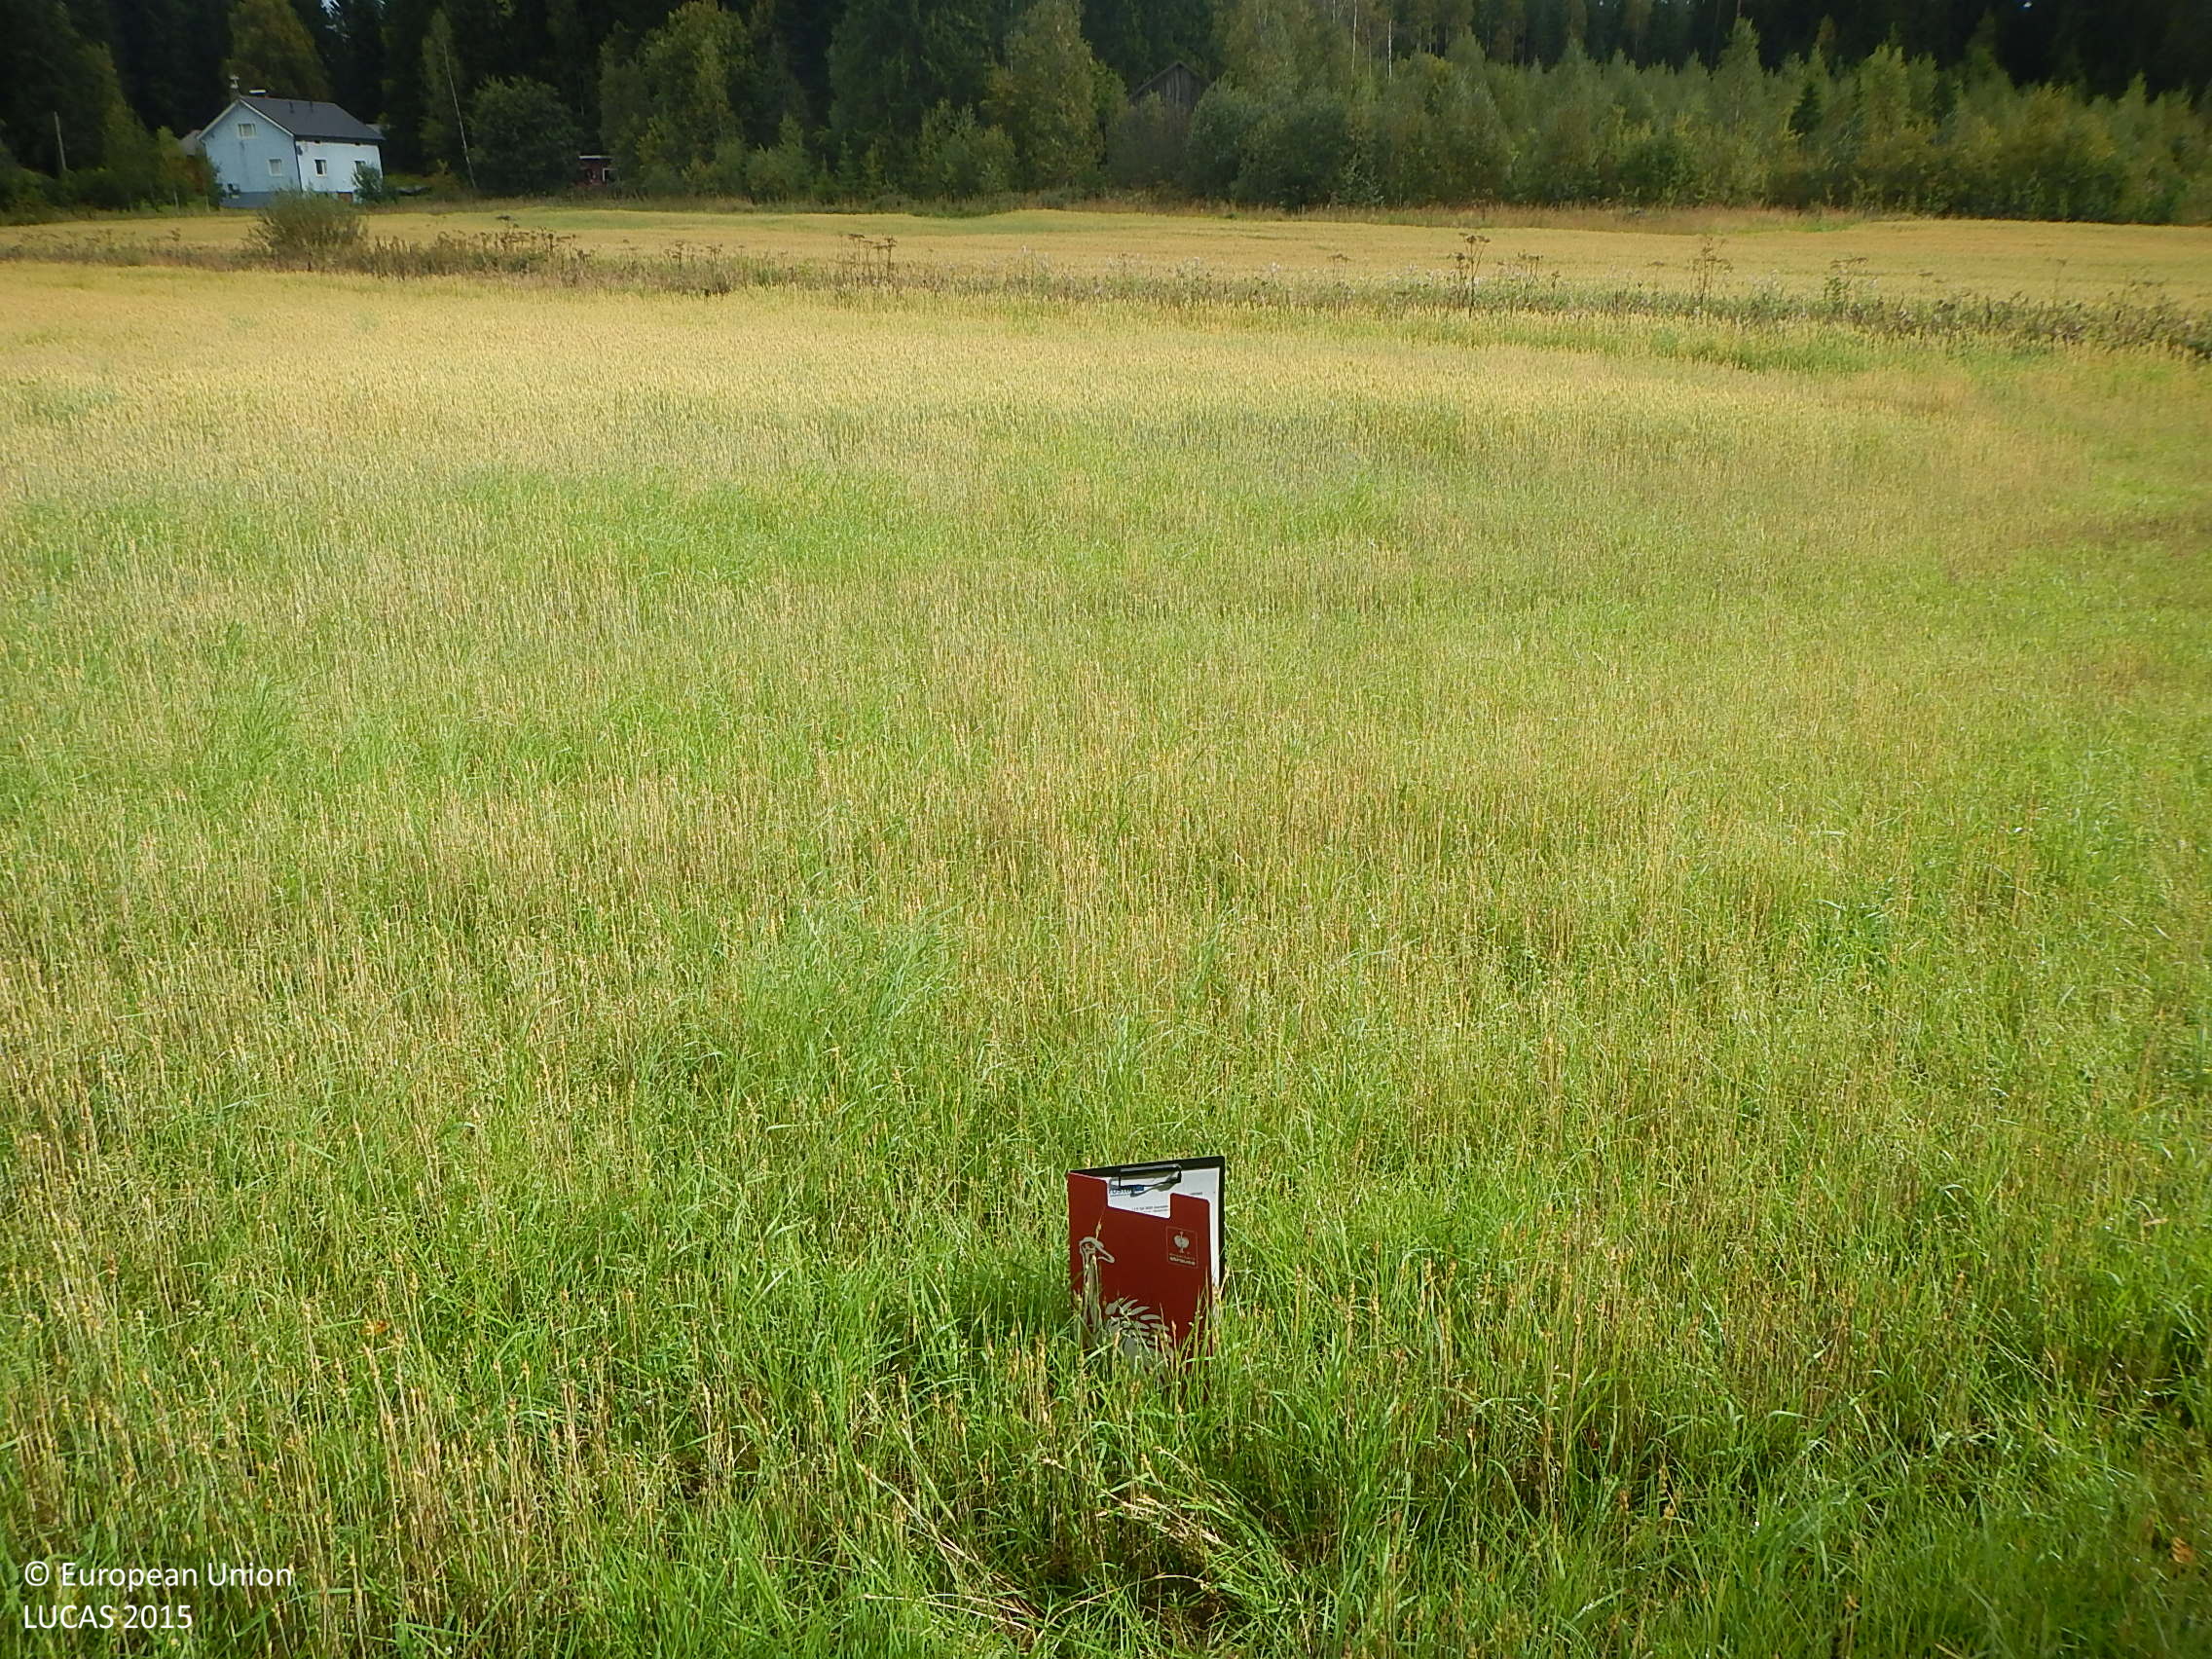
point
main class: Cropland
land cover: Common wheat
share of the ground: 25 - 50 %
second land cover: Spontaneously vegetated surfaces
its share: 50 - 75 %
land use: Agriculture (excluding fallow land and kitchen gardens)
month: September
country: FI
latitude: 61.4860
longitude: 22.7044
